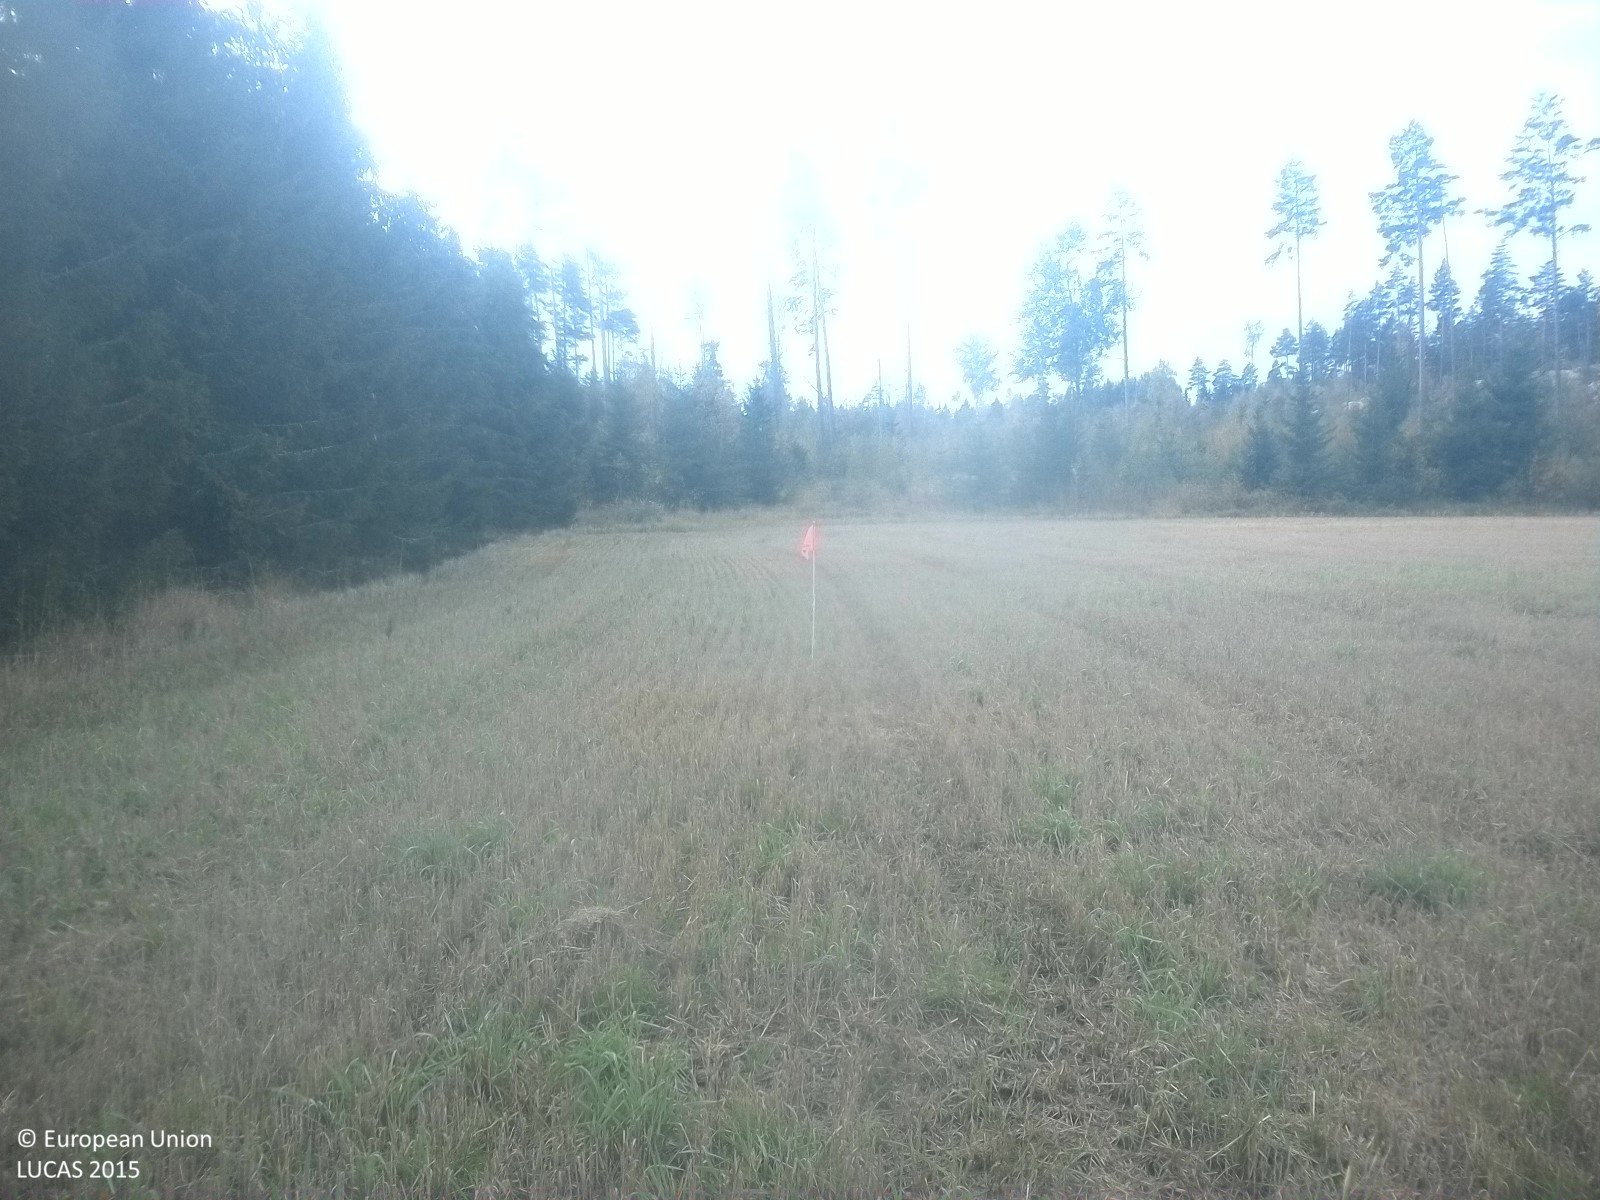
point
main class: Cropland
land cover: Barley
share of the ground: < 10 %
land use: Agriculture (excluding fallow land and kitchen gardens)
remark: Harvested field
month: September
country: SE
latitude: 58.6970
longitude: 16.8124
